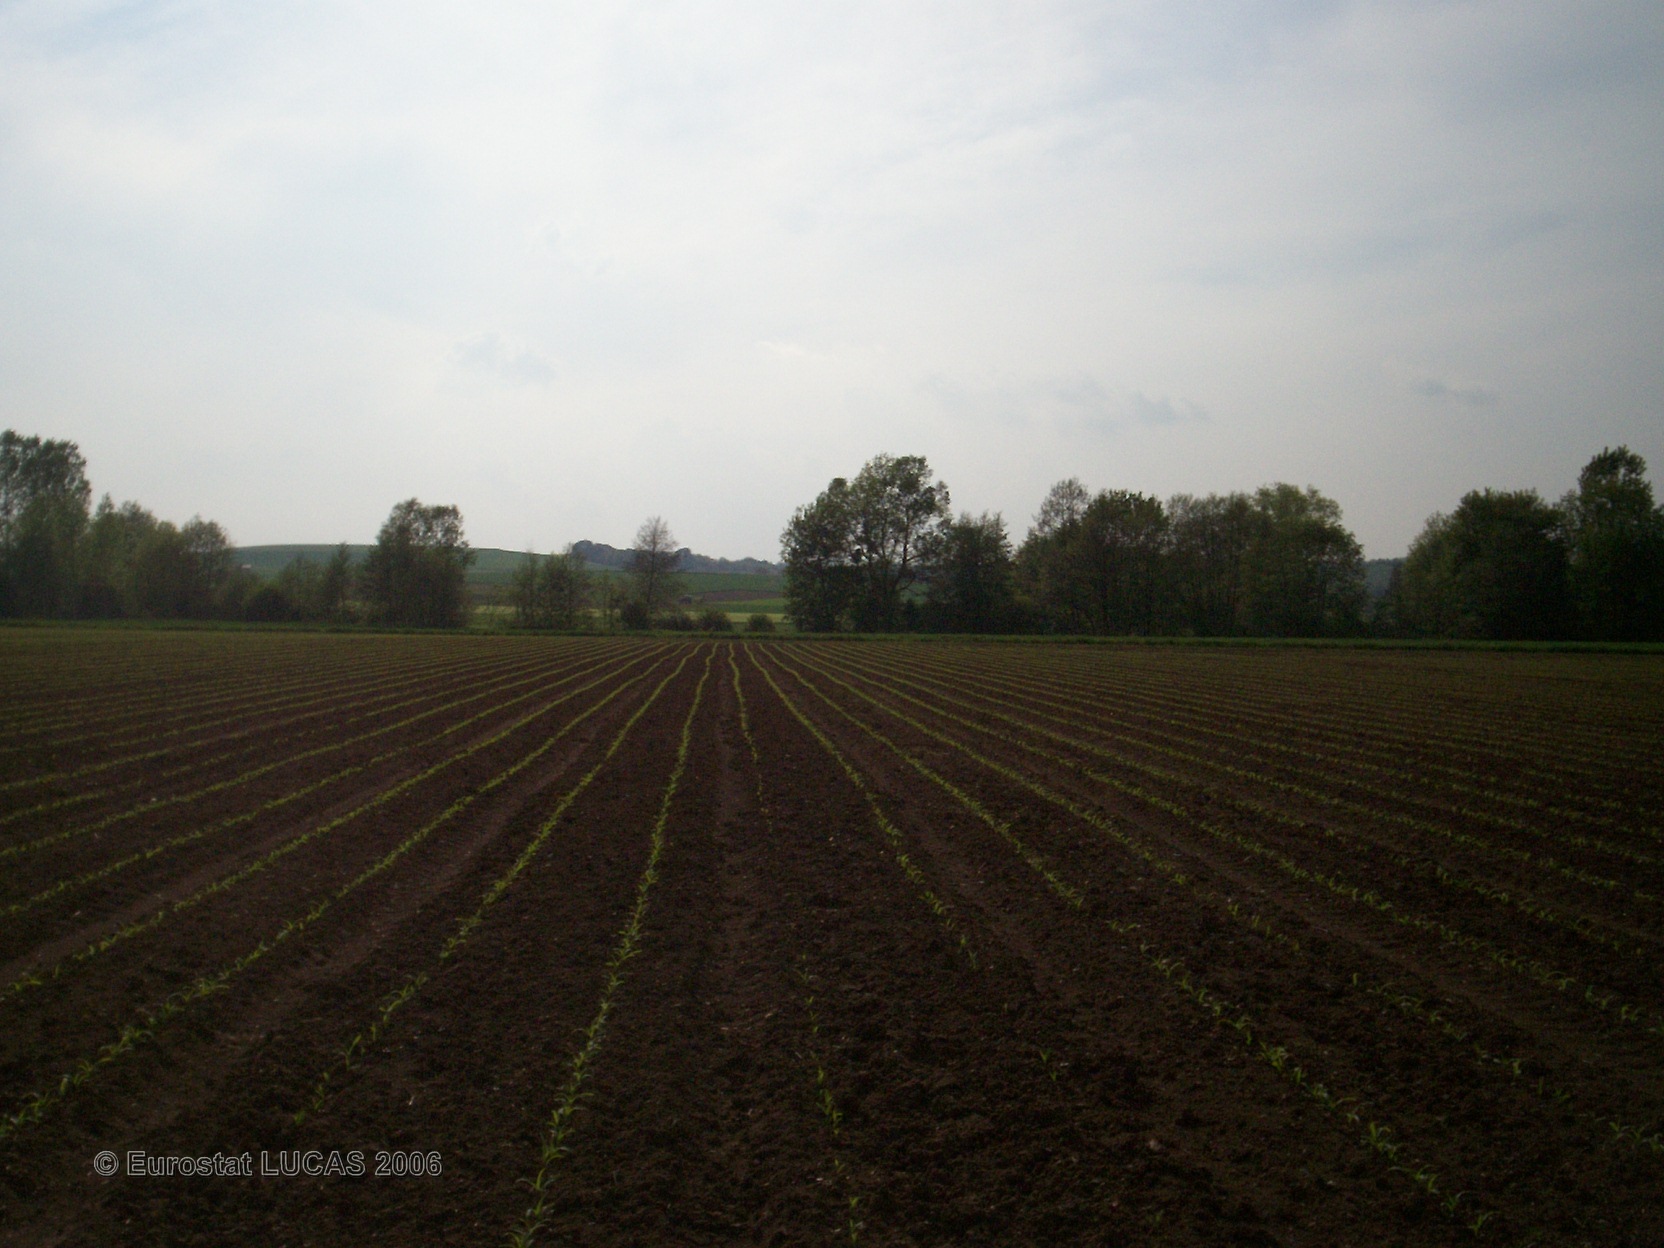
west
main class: Cropland
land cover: Maize
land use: Agriculture (excluding fallow land and kitchen gardens)
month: May
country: FR
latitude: 49.5915
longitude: 4.3099
